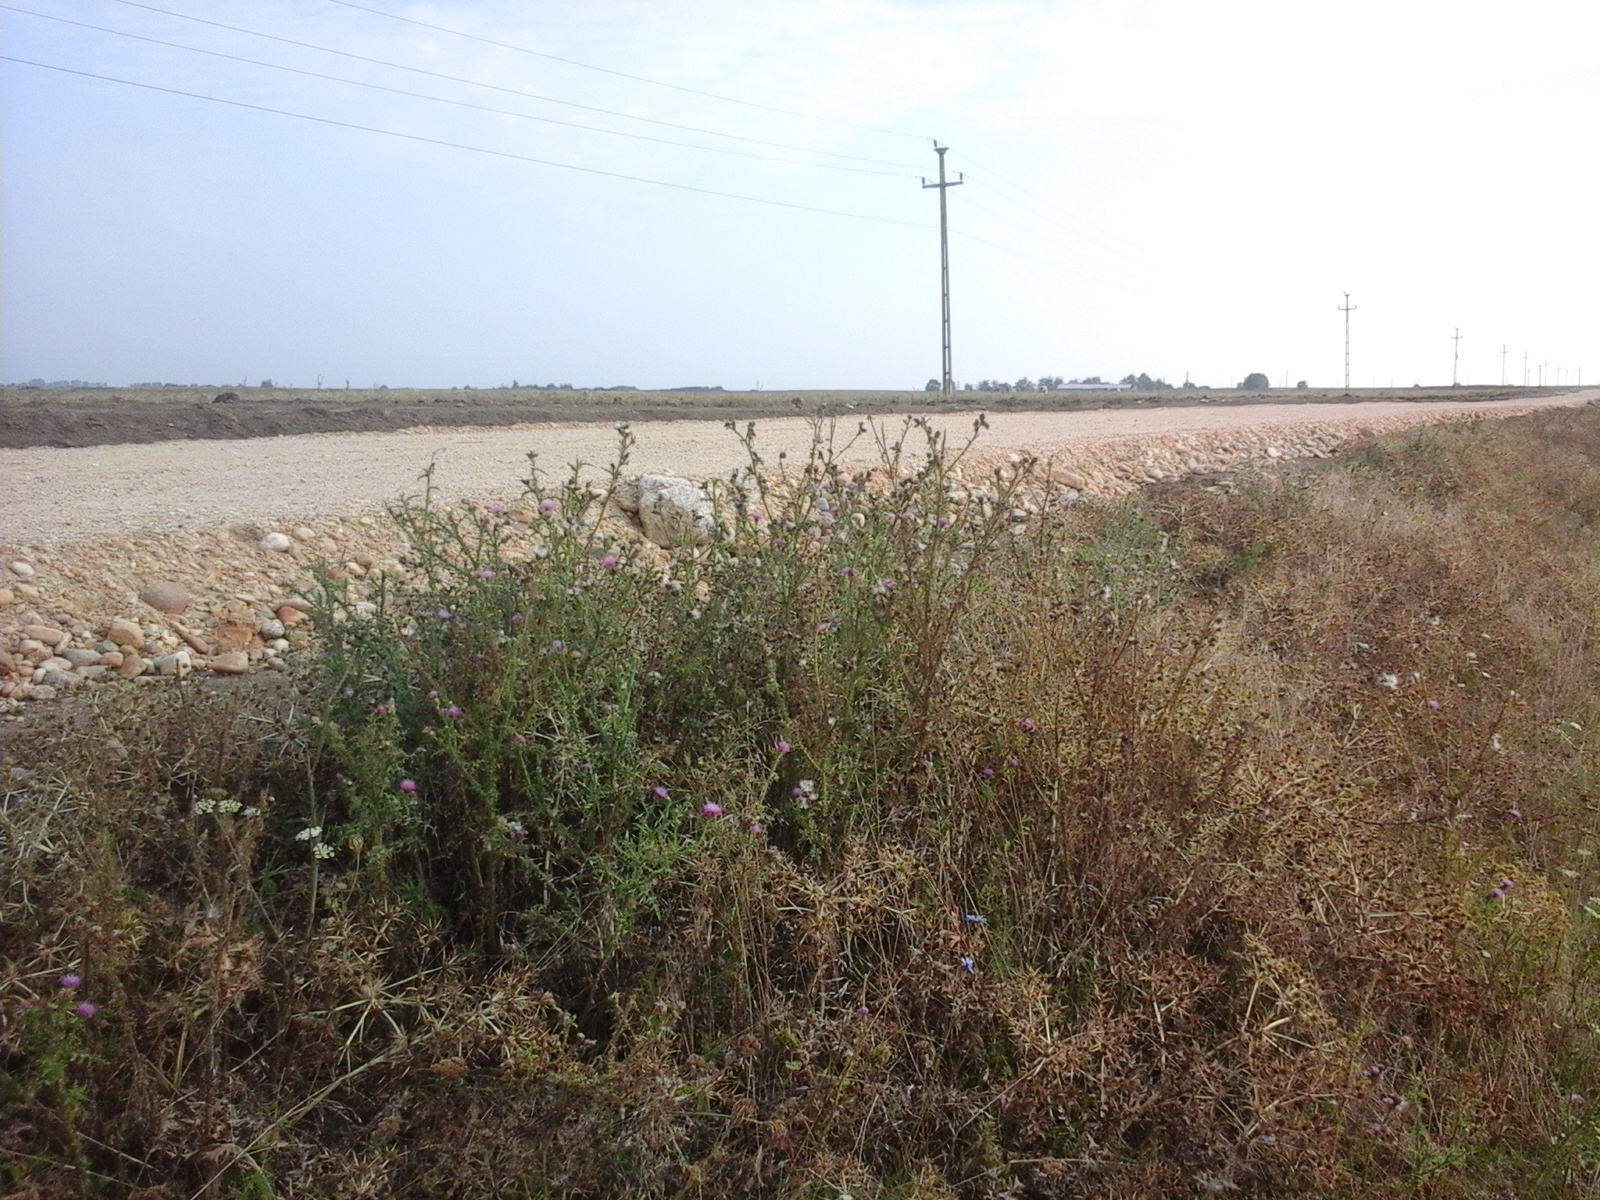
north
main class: Grassland
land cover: Grassland without tree/shrub cover
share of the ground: > 75 %
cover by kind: herbaceous plants 100 %
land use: Agriculture (excluding fallow land and kitchen gardens)
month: August
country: RO
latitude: 46.7067
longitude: 21.5365
